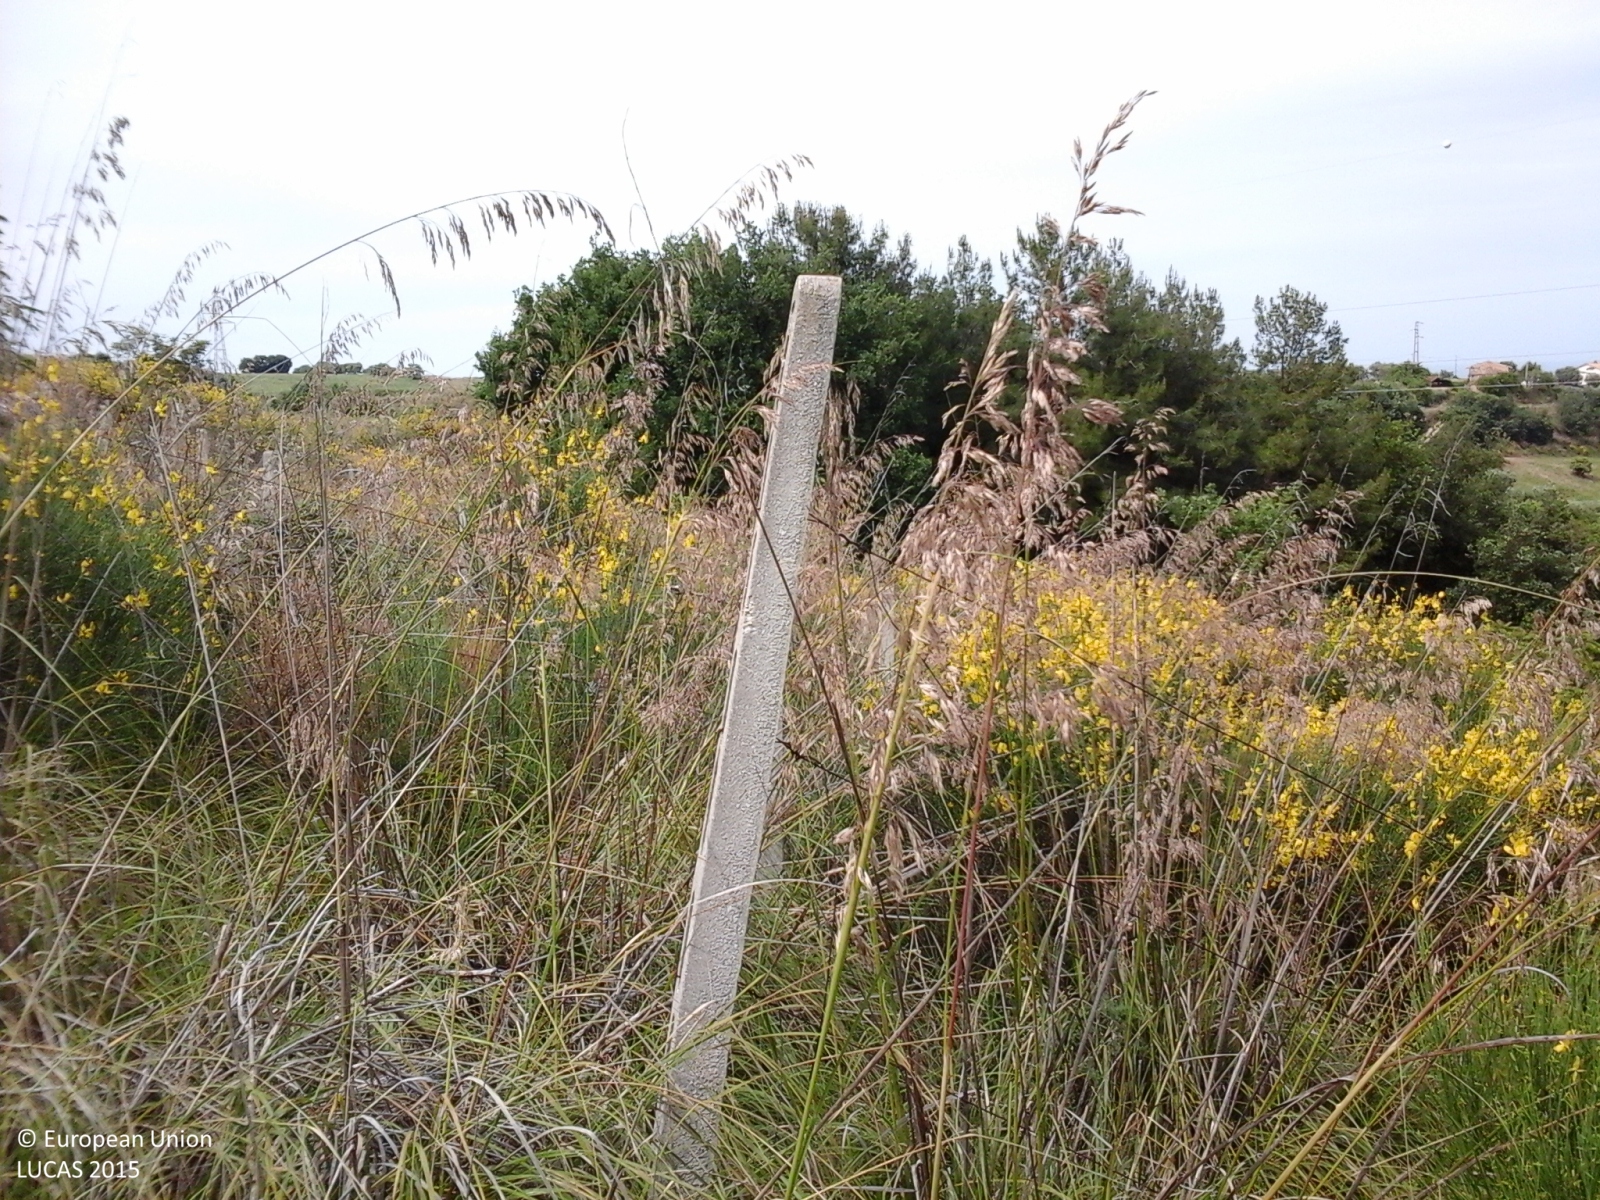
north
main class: Cropland
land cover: Vineyards
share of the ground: 50 - 75 %
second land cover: Spontaneously vegetated surfaces
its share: > 75 %
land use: Abandoned areas
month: May
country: IT
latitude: 42.9974
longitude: 13.8291
